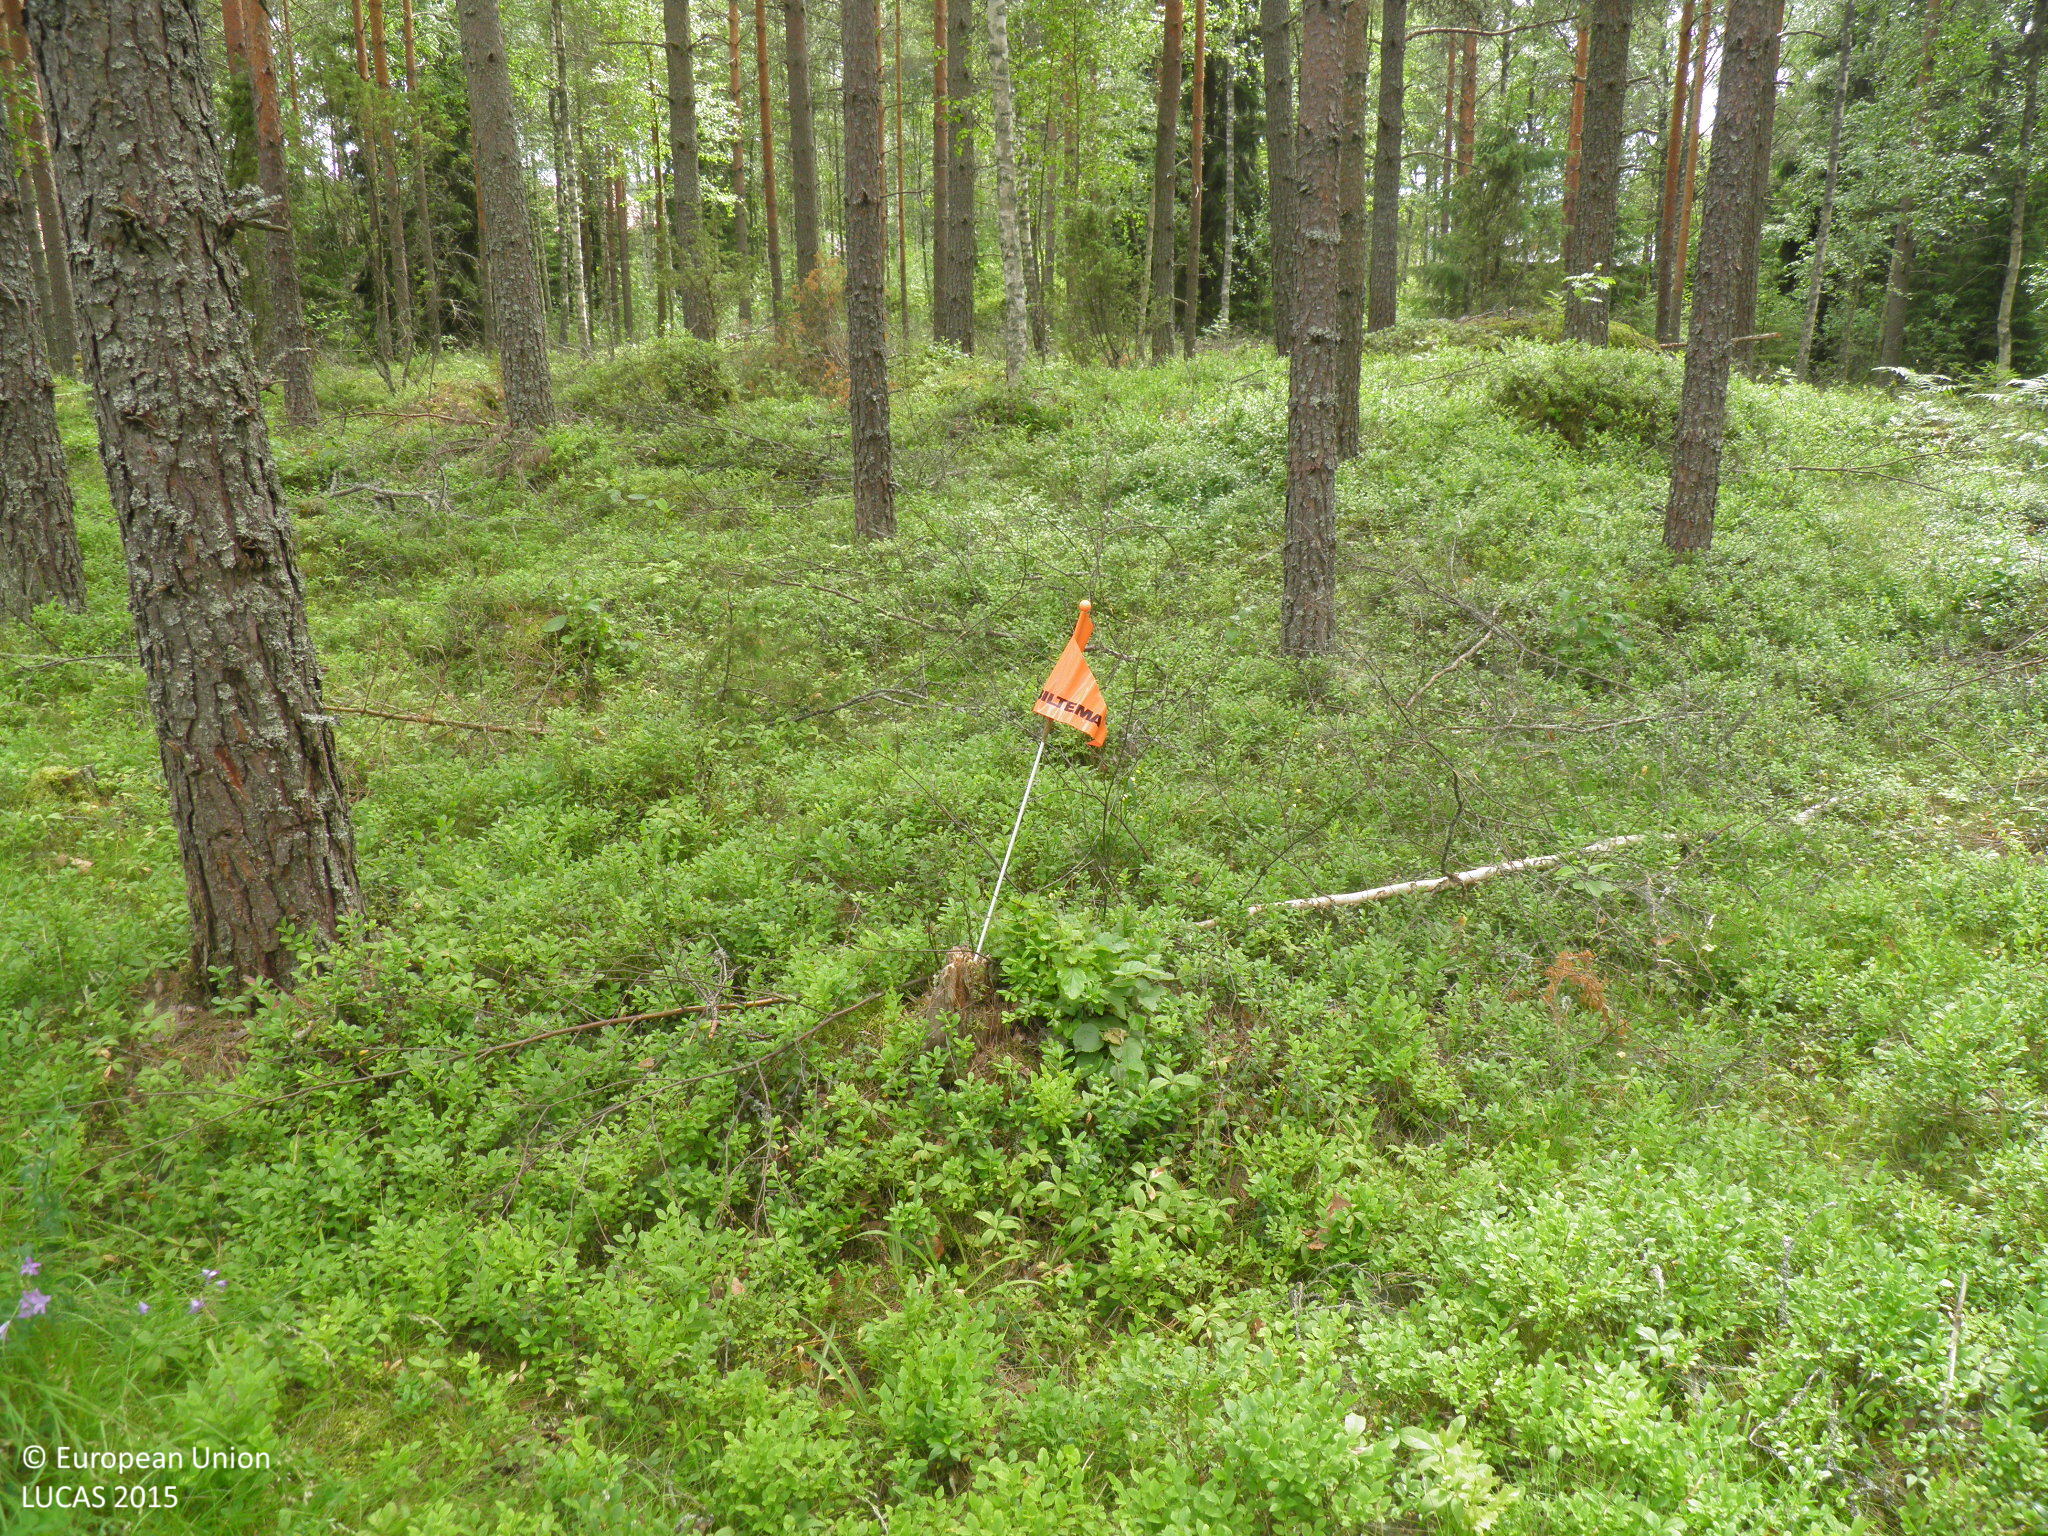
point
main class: Woodland
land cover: Pine dominated coniferous woodland
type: boreal forest
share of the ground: 50 - 75 %
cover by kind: coniferous forest trees 55 %, broadleaved forest trees 15 %, shrubs 15 %, herbaceous plants 15 %
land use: Forestry
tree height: > 5 m
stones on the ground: < 10 %
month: July
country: FI
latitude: 60.7215
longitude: 22.6644
